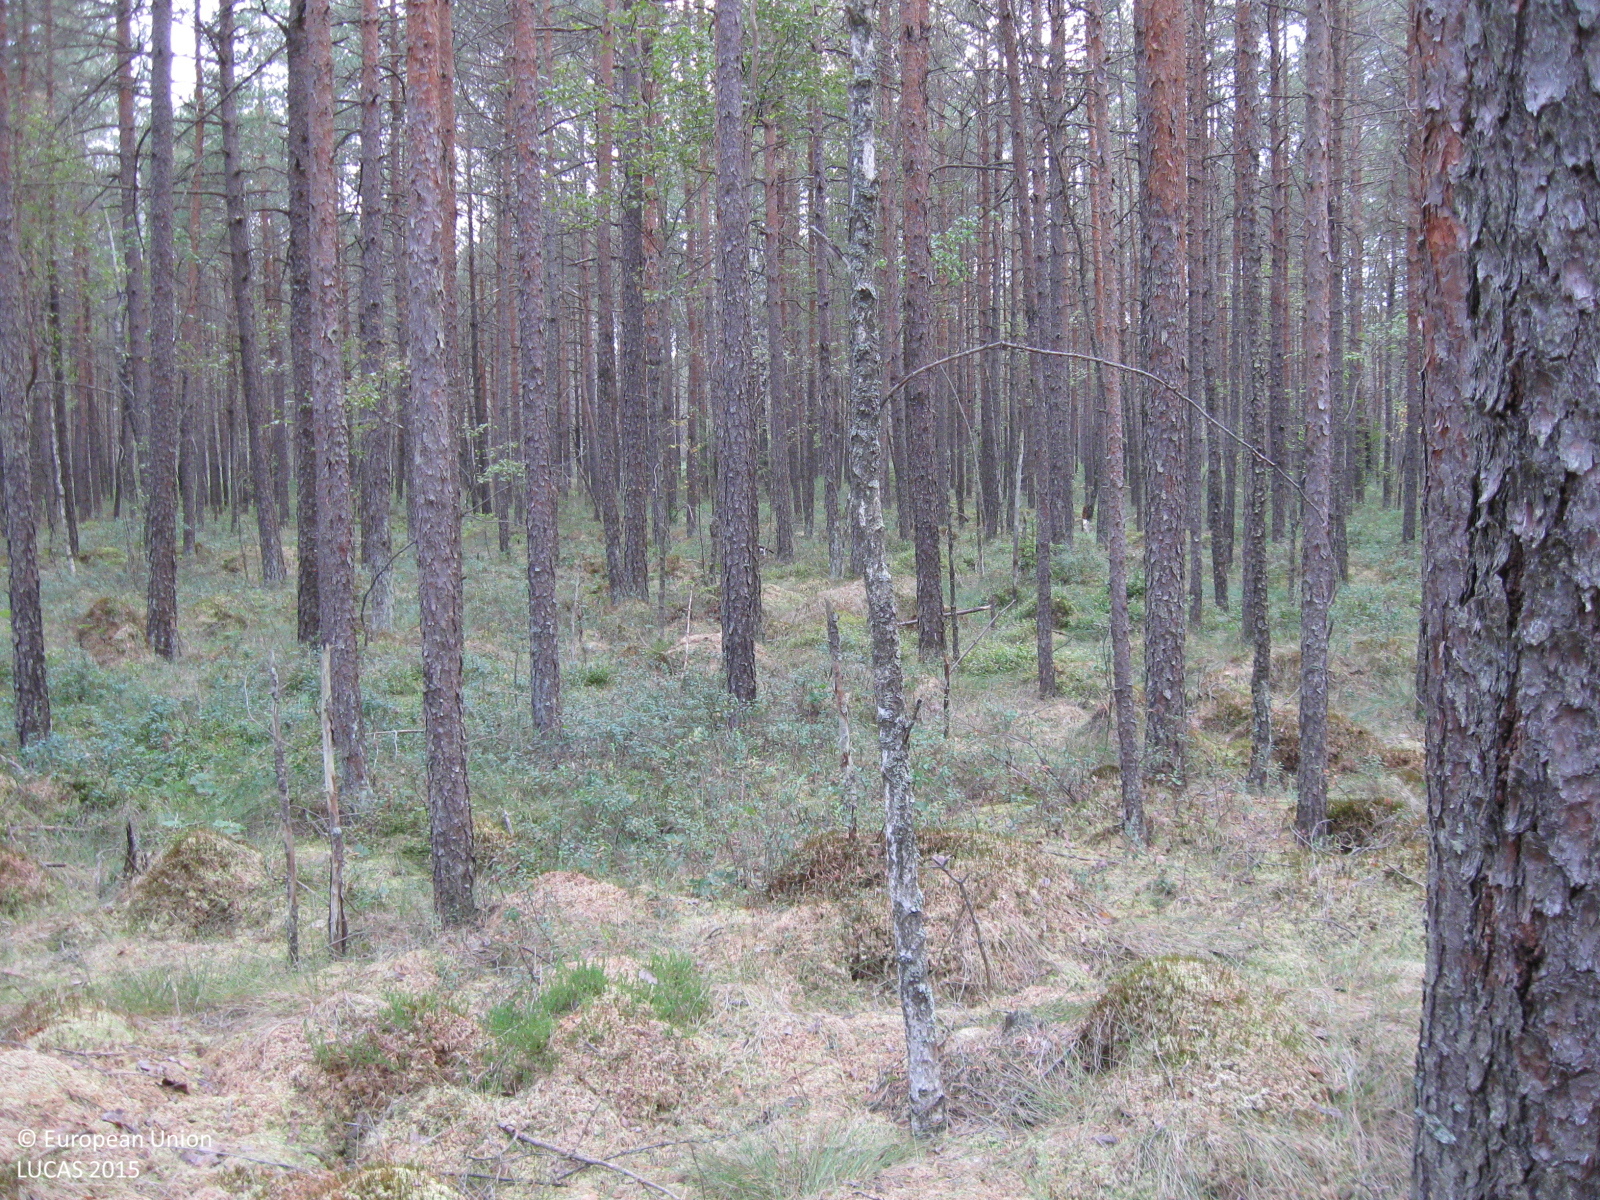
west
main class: Woodland
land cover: Pine dominated coniferous woodland
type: mire and swamp forests
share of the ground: > 75 %
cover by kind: coniferous forest trees 75 %, herbaceous plants 10 %, lichens and mosses 10 %, broadleaved forest trees 5 %
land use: Forestry
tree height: > 5 m
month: August
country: LT
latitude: 55.5594
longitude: 23.3462
